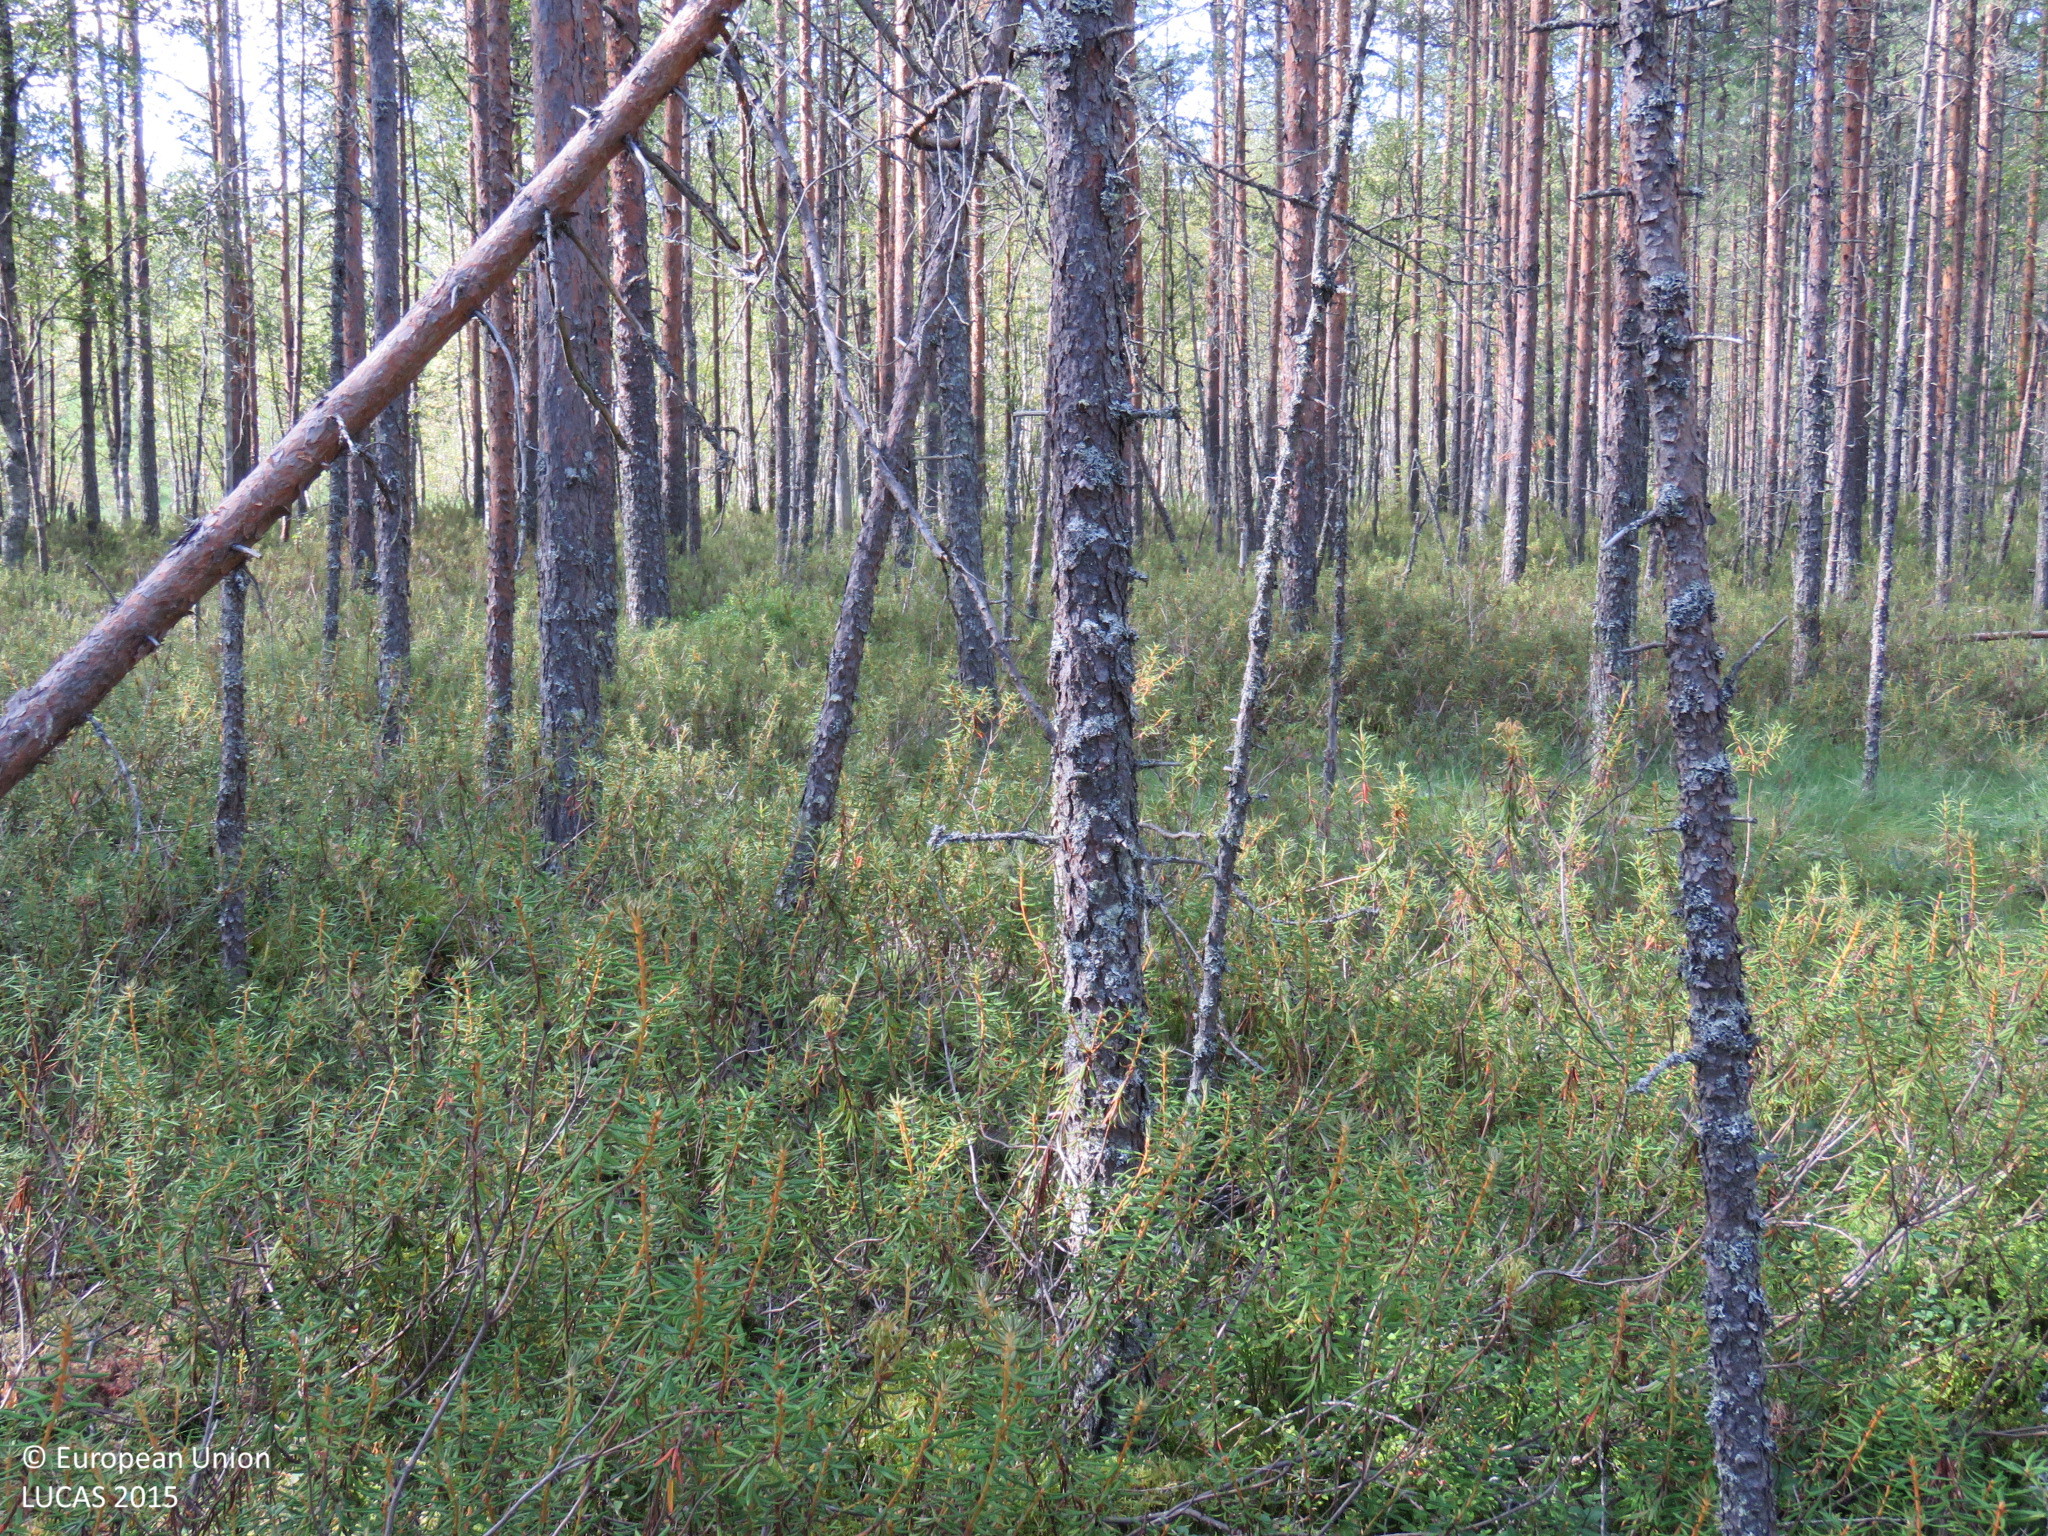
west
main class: Woodland
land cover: Pine dominated coniferous woodland
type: mire and swamp forests
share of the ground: > 75 %
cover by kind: coniferous forest trees 70 %, shrubs 20 %, broadleaved forest trees 5 %, lichens and mosses 5 %
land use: Forestry
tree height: > 5 m
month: August
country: FI
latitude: 65.1480
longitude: 25.6742
